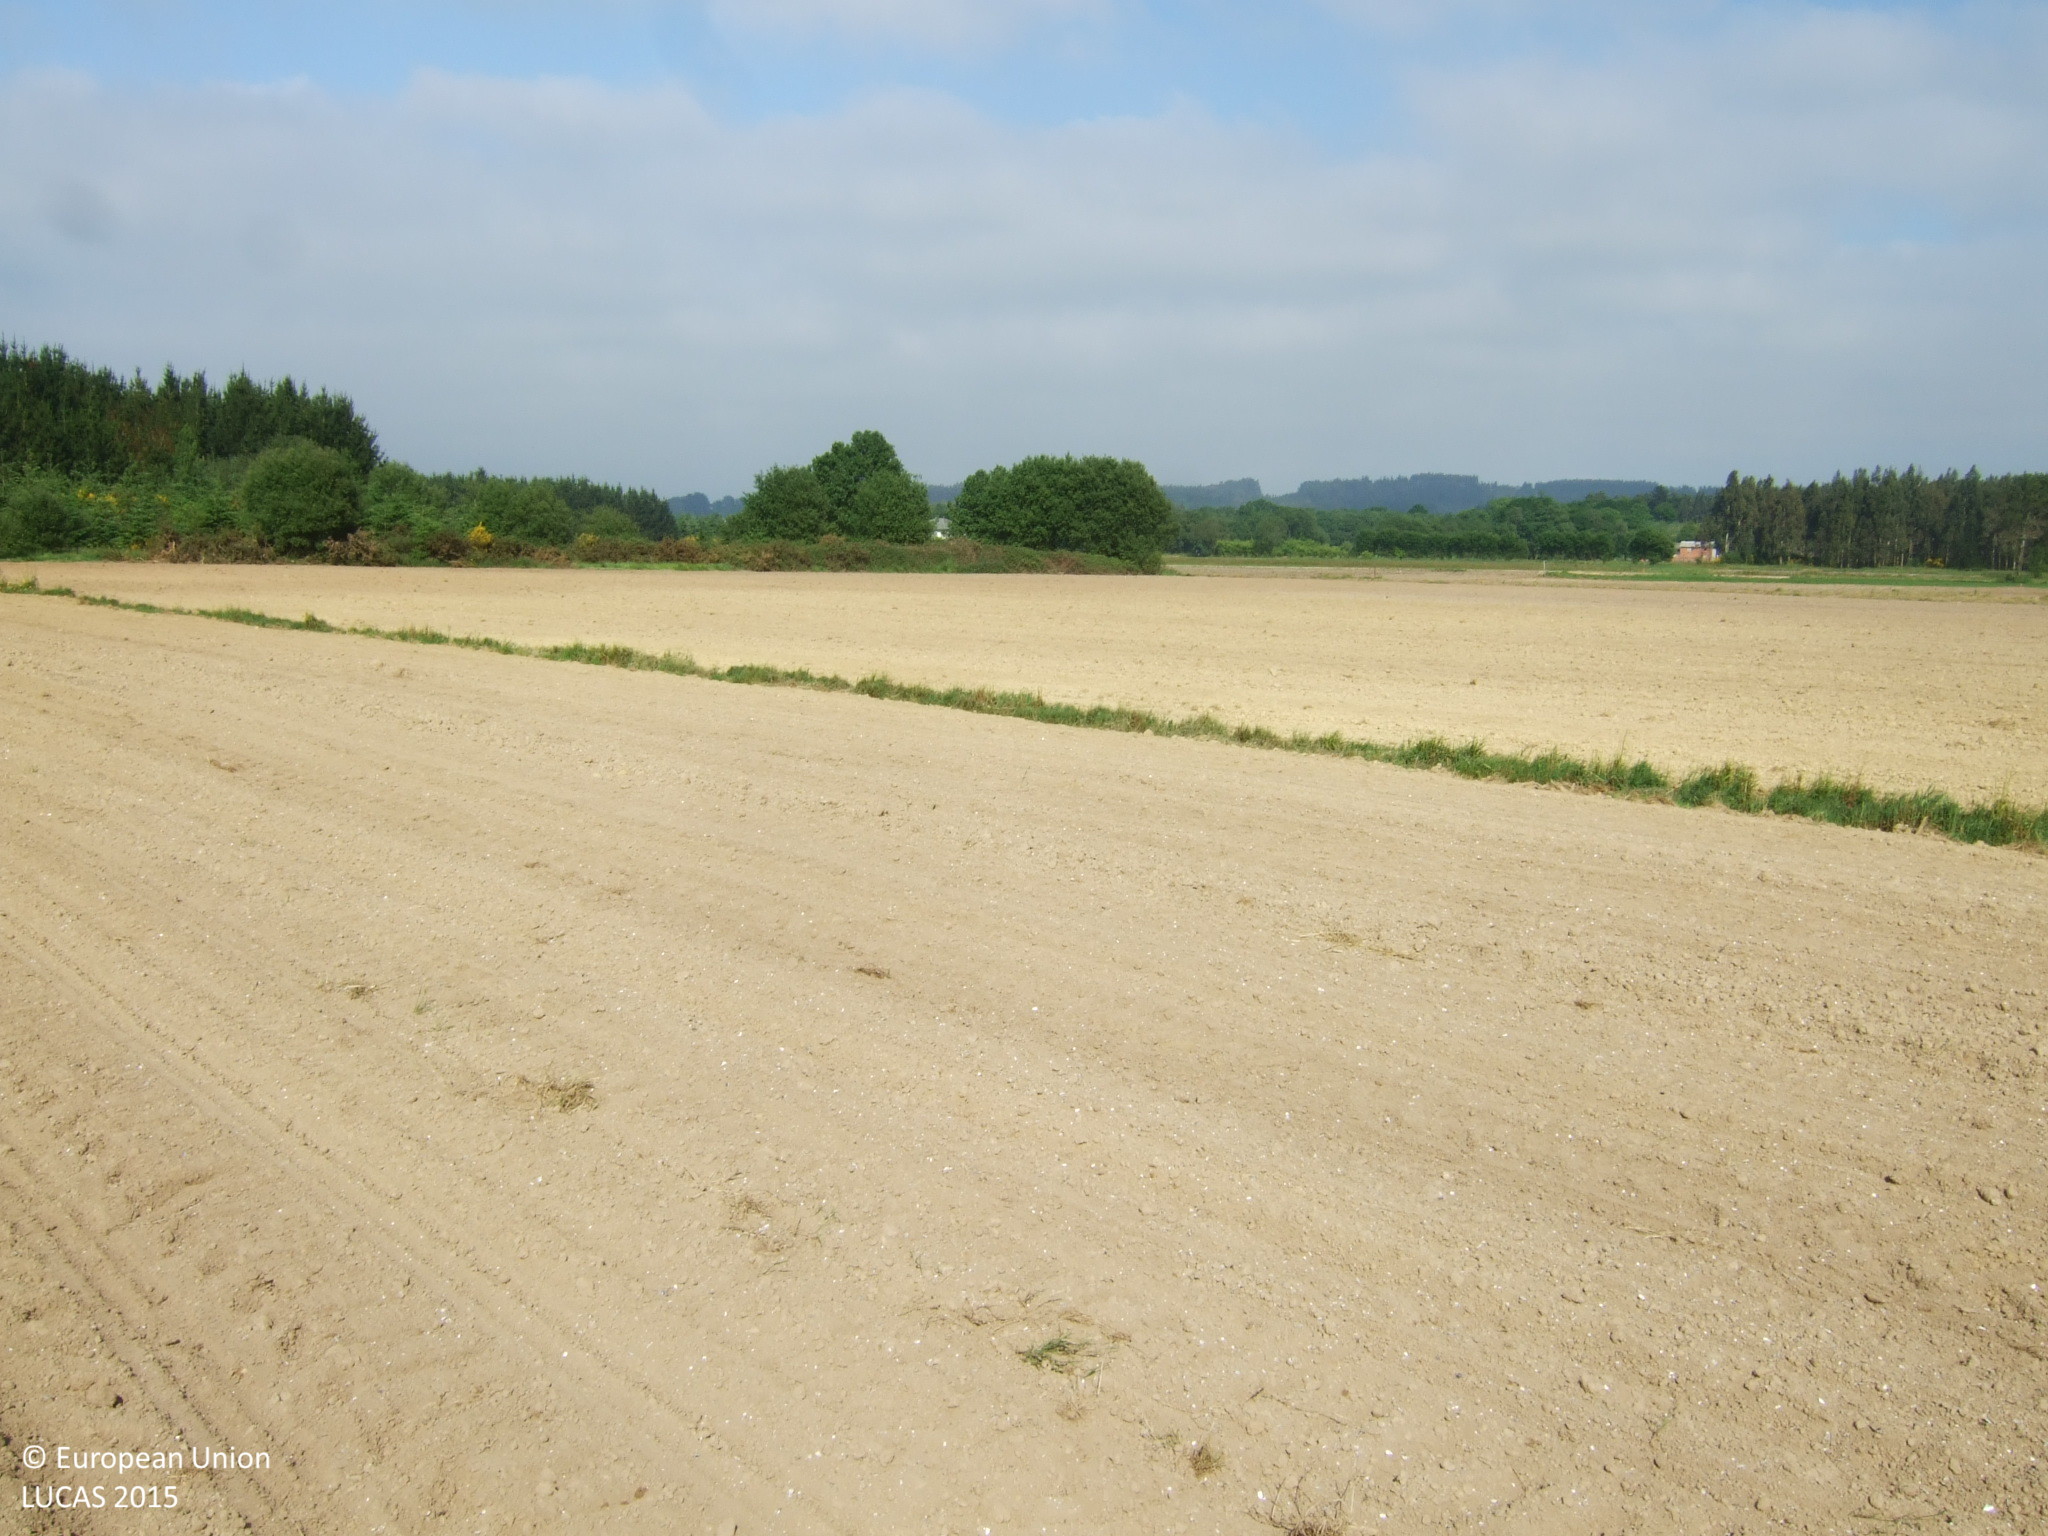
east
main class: Cropland
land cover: Maize
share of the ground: < 10 %
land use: Agriculture (excluding fallow land and kitchen gardens)
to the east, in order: Maize; Broadleaved woodland; Tracks; Maize
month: June
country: ES
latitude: 43.2523
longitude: -7.4064
